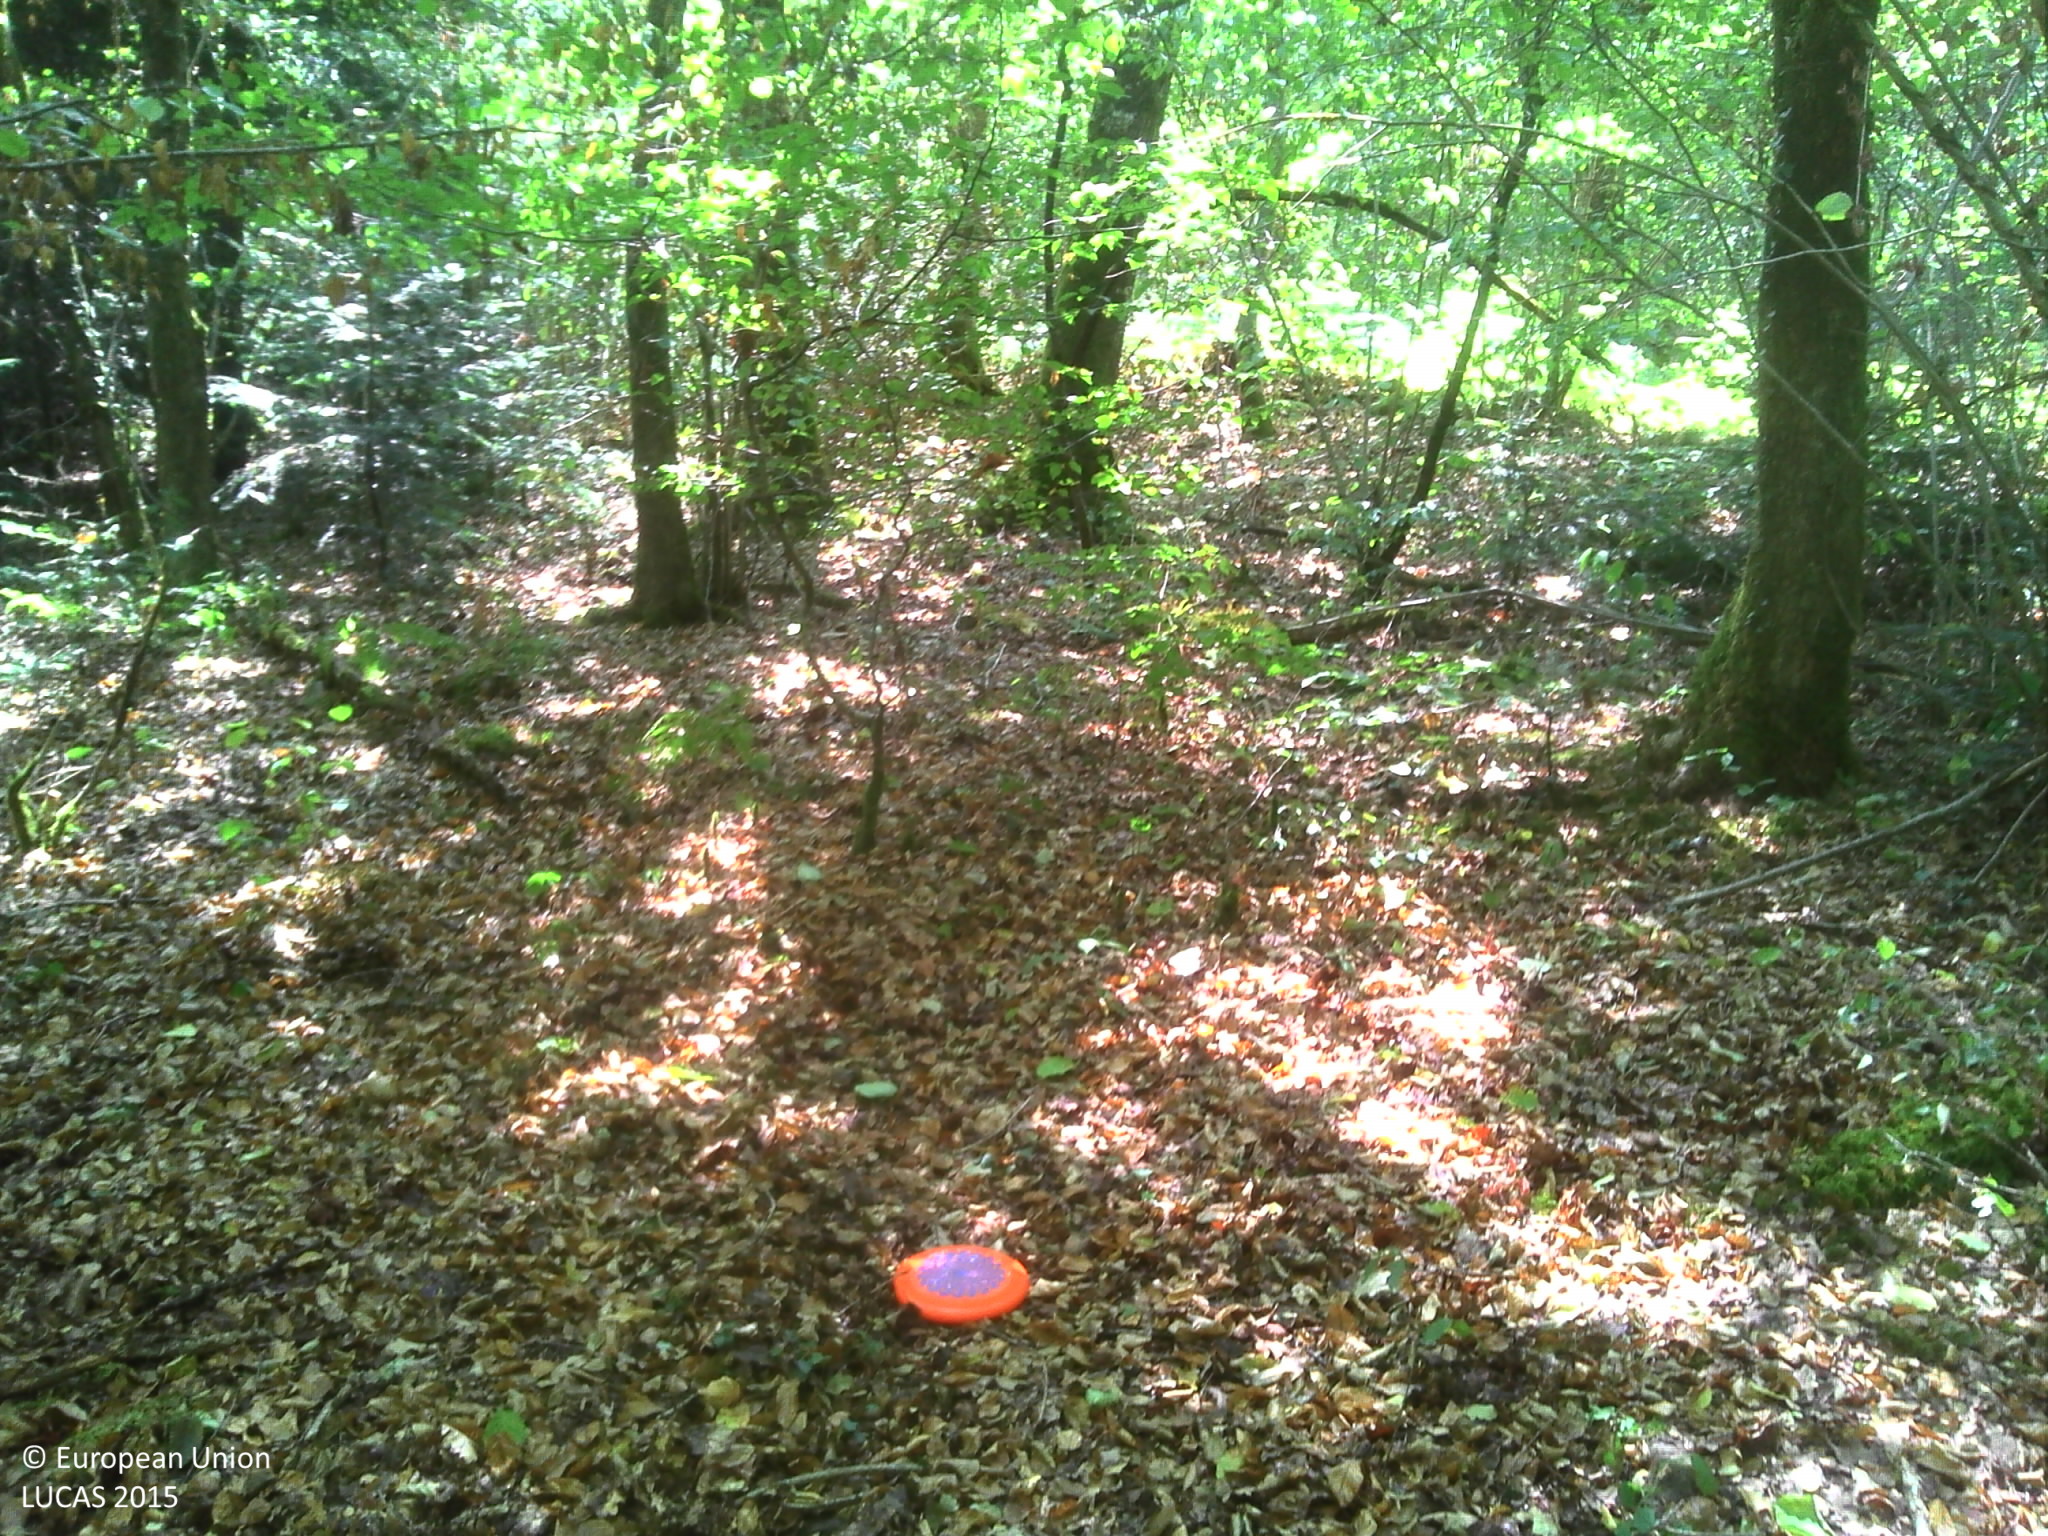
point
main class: Woodland
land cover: Broadleaved woodland
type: mesophytic deciduous forest
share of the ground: > 75 %
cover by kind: broadleaved forest trees 90 %, herbaceous plants 10 %
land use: Forestry
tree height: > 5 m
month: July
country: FR
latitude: 46.5285
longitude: 4.3820
